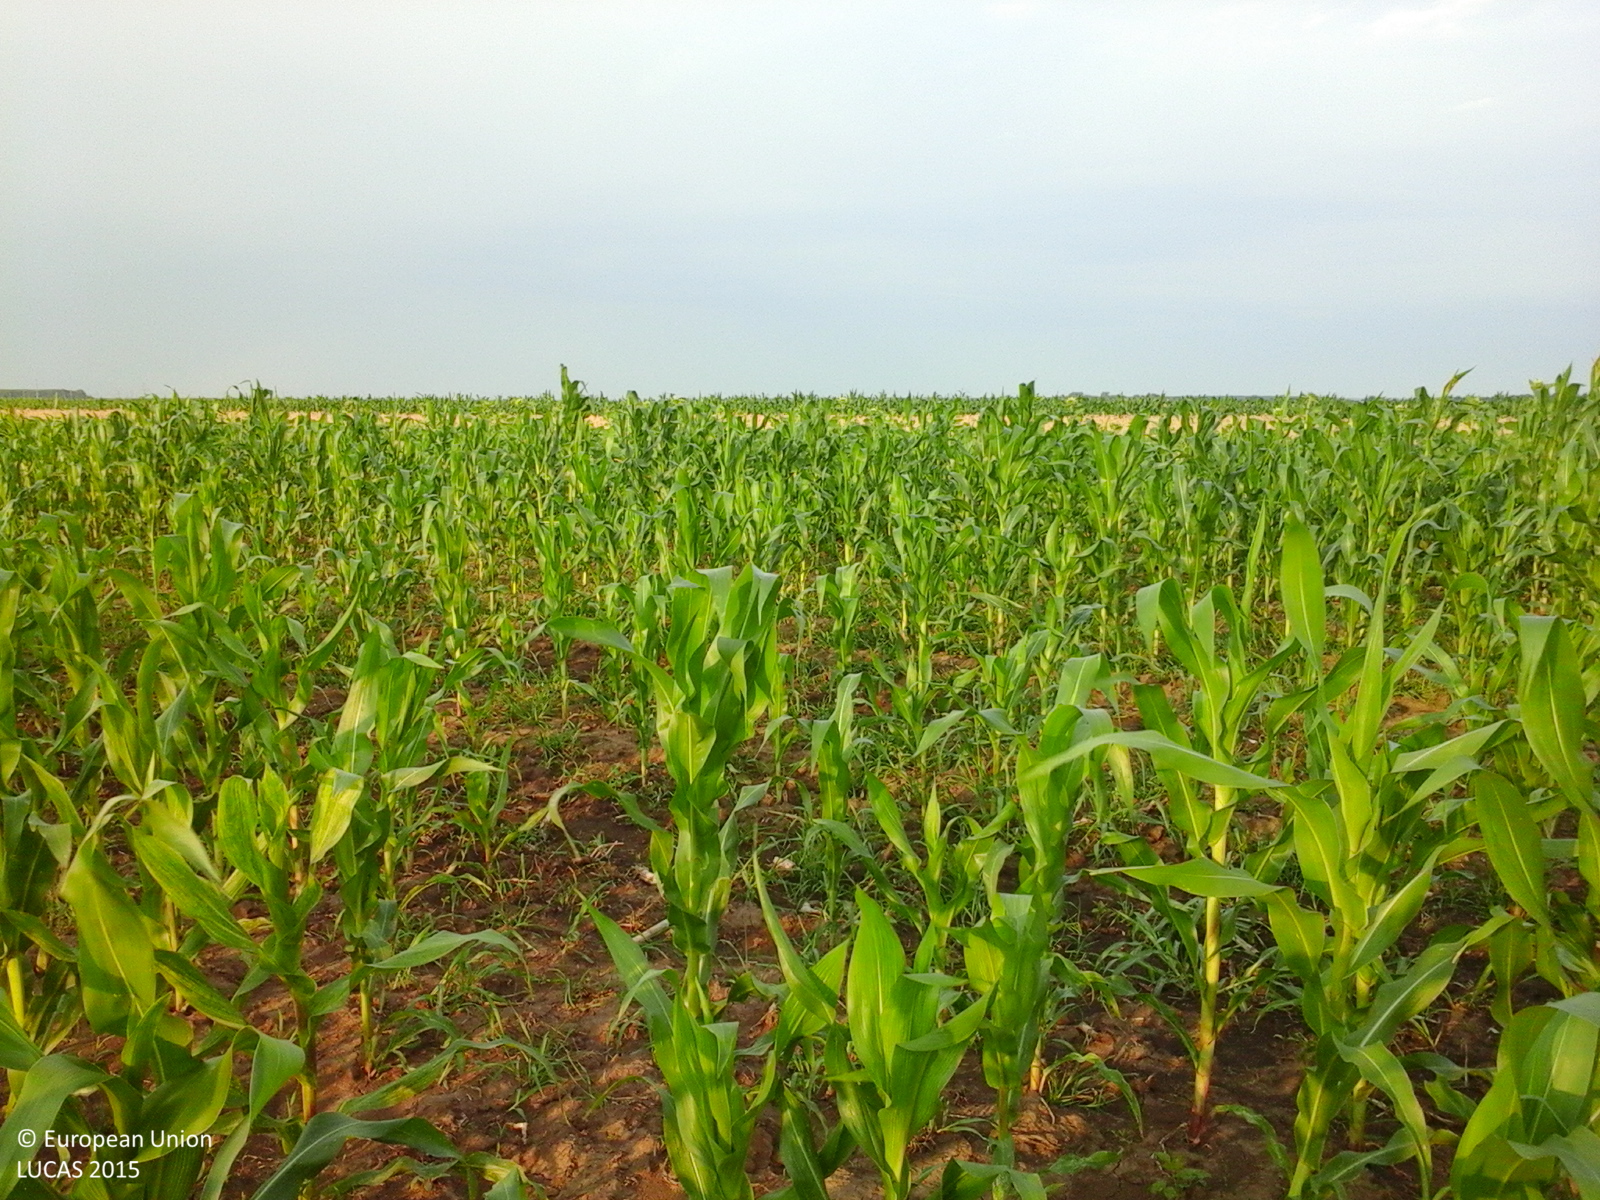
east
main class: Cropland
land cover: Maize
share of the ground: 50 - 75 %
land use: Agriculture (excluding fallow land and kitchen gardens)
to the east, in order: Maize; Sunflower; Common wheat; Maize; Barley; Grass margins; Common wheat
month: July
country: RO
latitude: 44.2822
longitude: 25.5918
